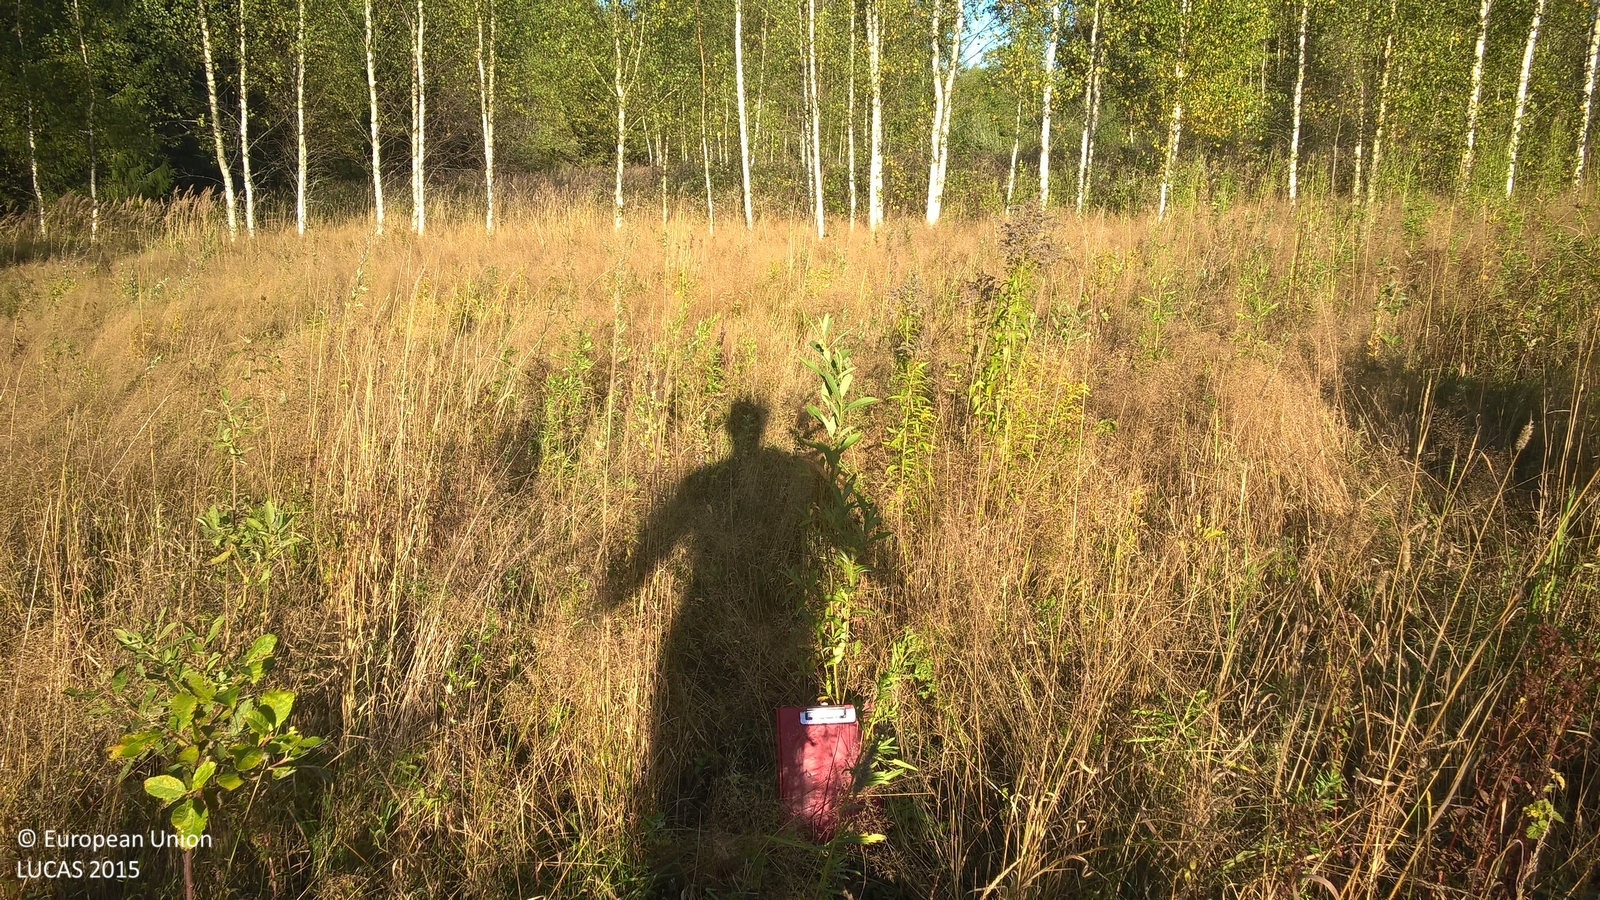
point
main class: Grassland
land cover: Spontaneously vegetated surfaces
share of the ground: > 75 %
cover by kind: herbaceous plants 100 %
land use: Fallow land
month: September
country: LV
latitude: 57.6046
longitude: 25.6657
